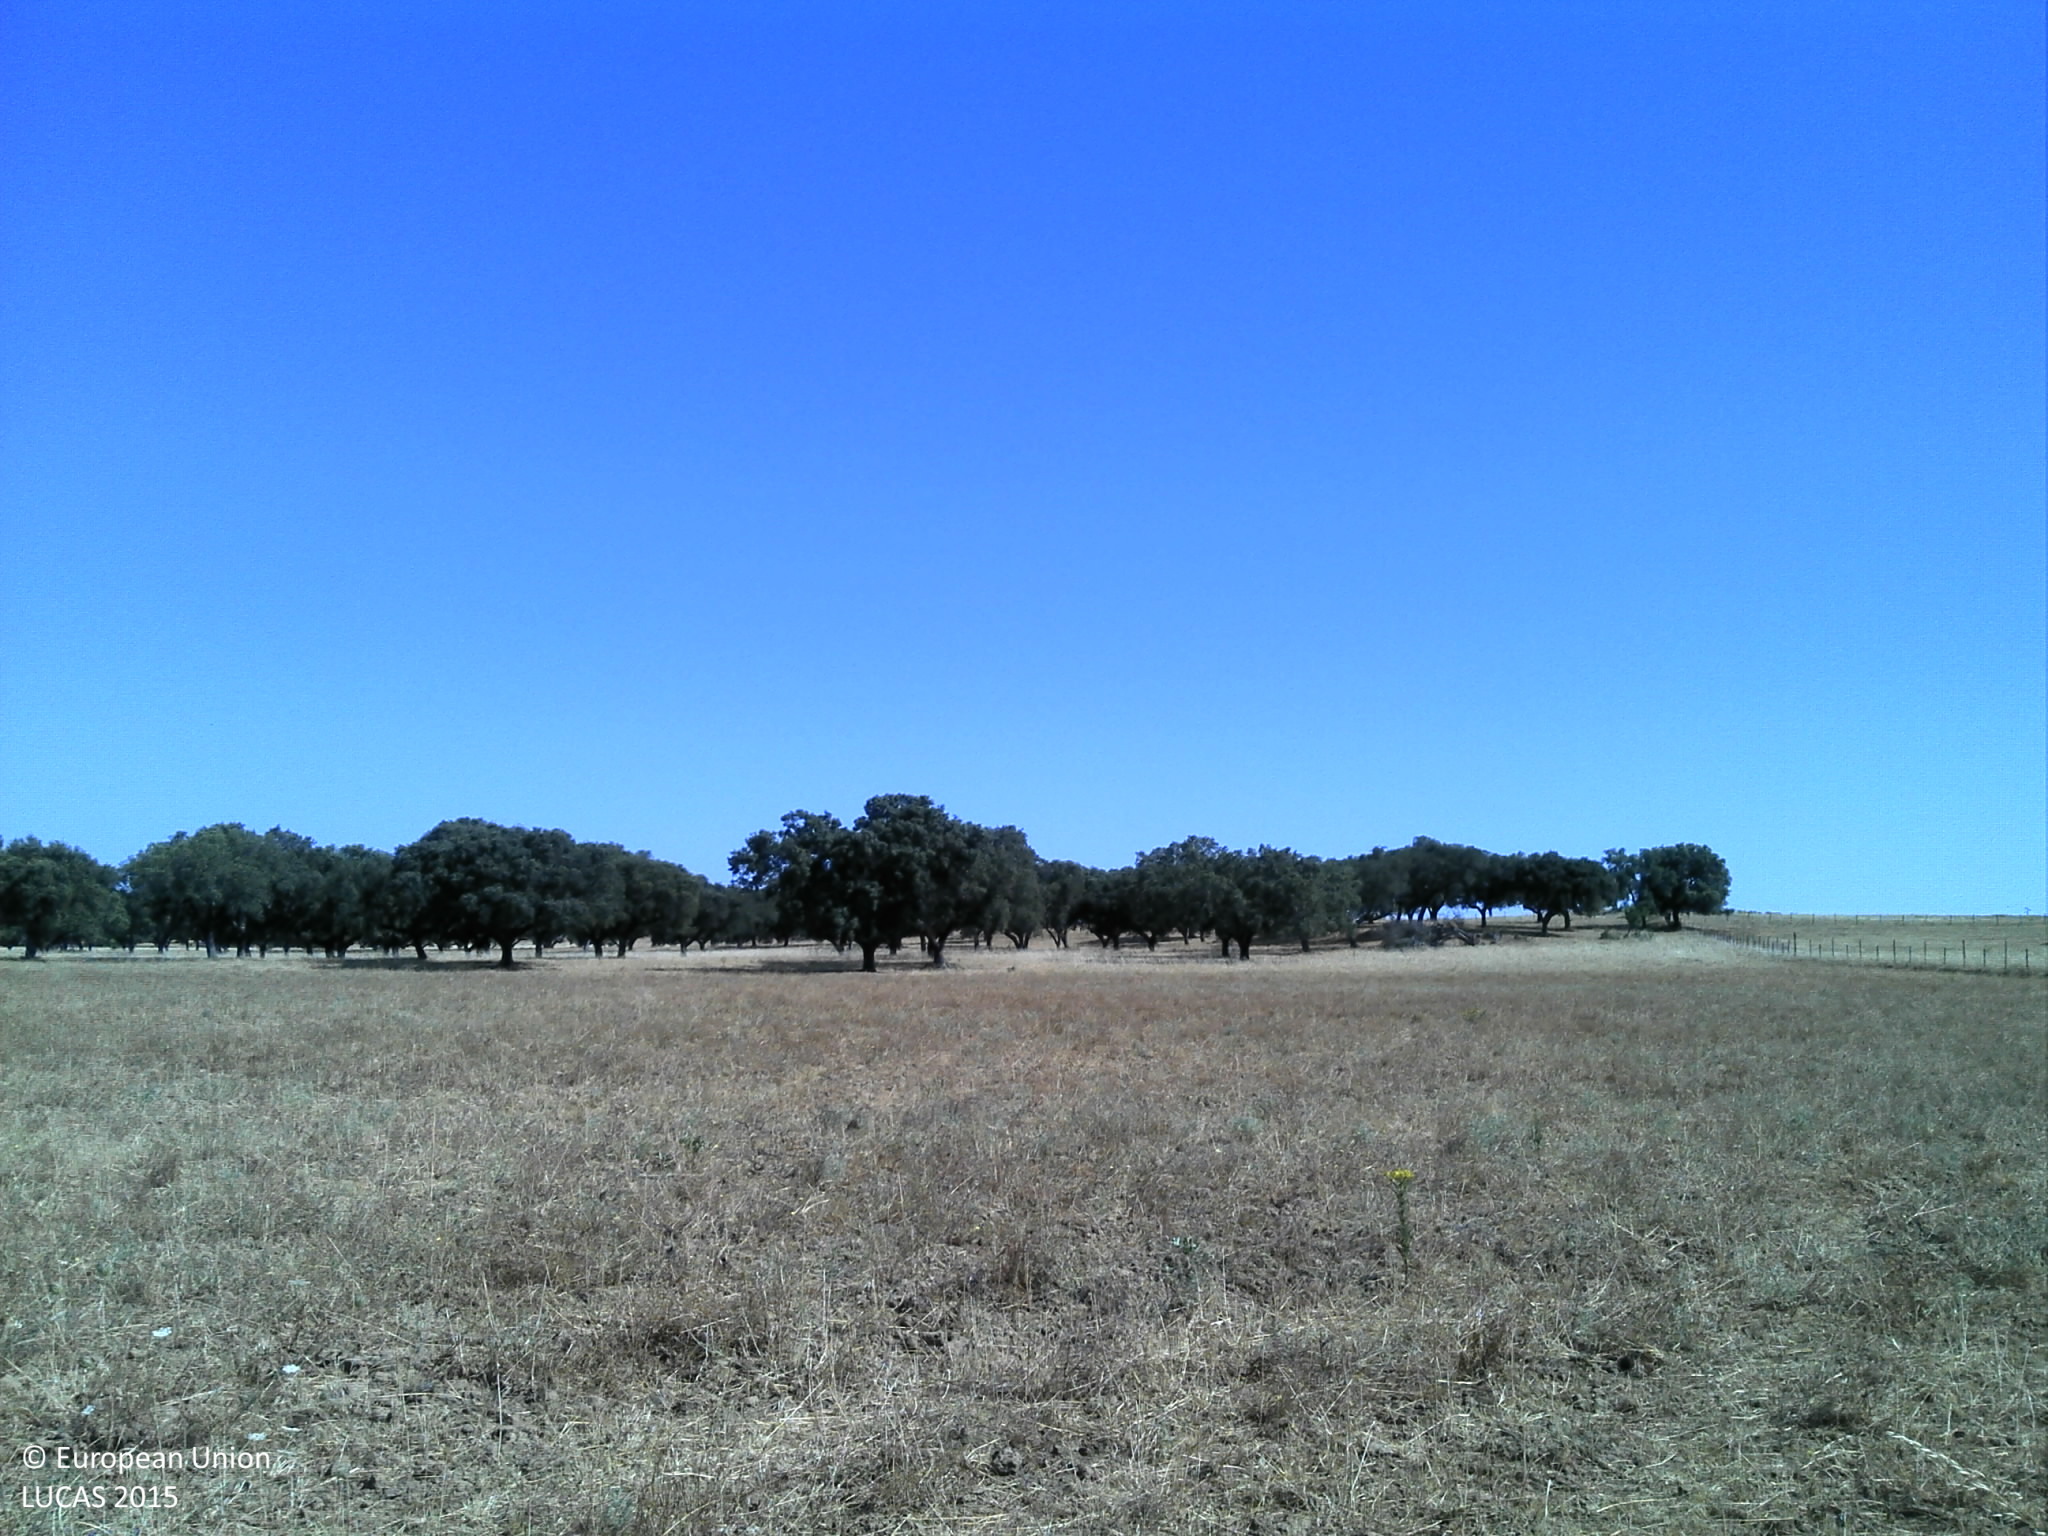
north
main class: Woodland
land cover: Broadleaved woodland
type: broadleaved evergreen forest
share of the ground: 10 - 25 %
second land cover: Grassland without tree/shrub cover
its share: 10 - 25 %
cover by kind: unconsolidated bare surface 70 %, broadleaved forest trees 15 %, herbaceous plants 15 %
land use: Forestry
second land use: Agriculture (excluding fallow land and kitchen gardens)
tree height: > 5 m
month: June
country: PT
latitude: 38.4544
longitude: -8.1134
